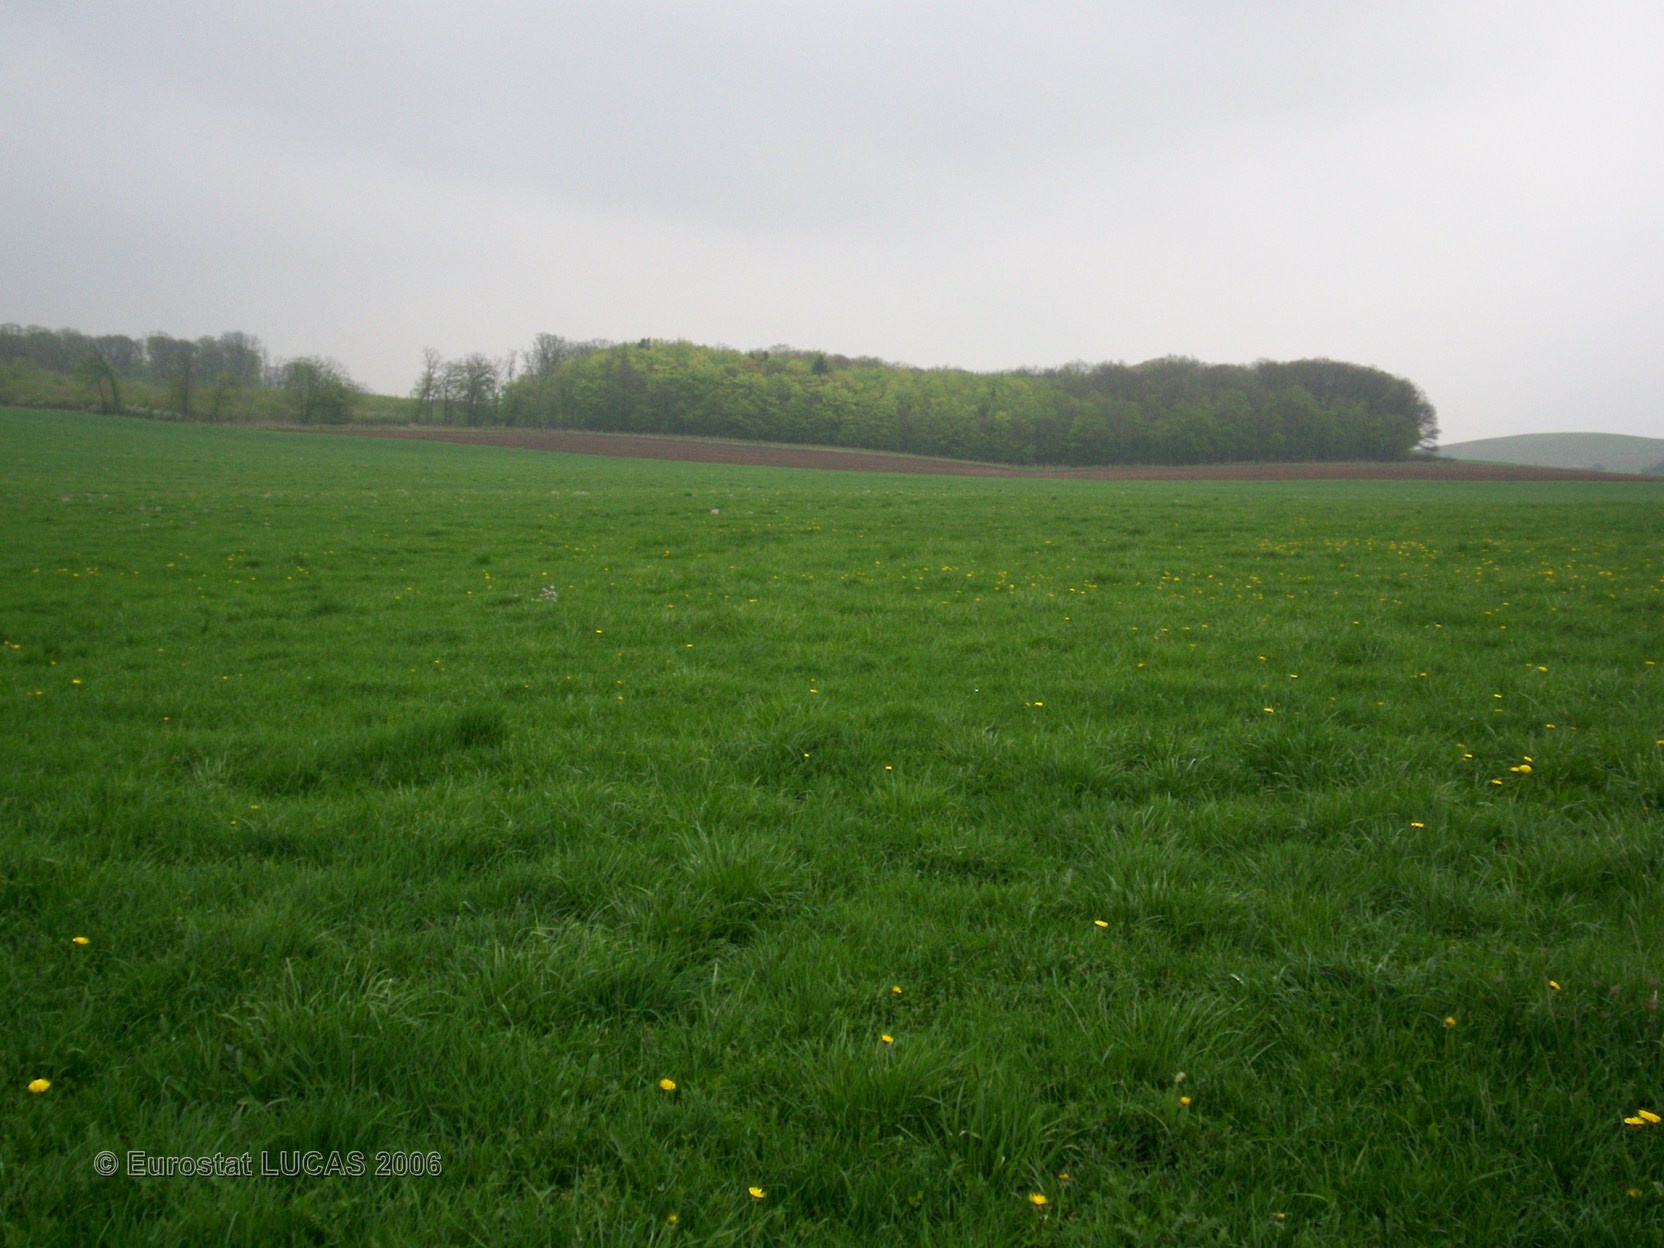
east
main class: Grassland
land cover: Grassland without tree/shrub cover
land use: Agriculture (excluding fallow land and kitchen gardens)
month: April
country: FR
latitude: 48.9152
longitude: 6.7936
